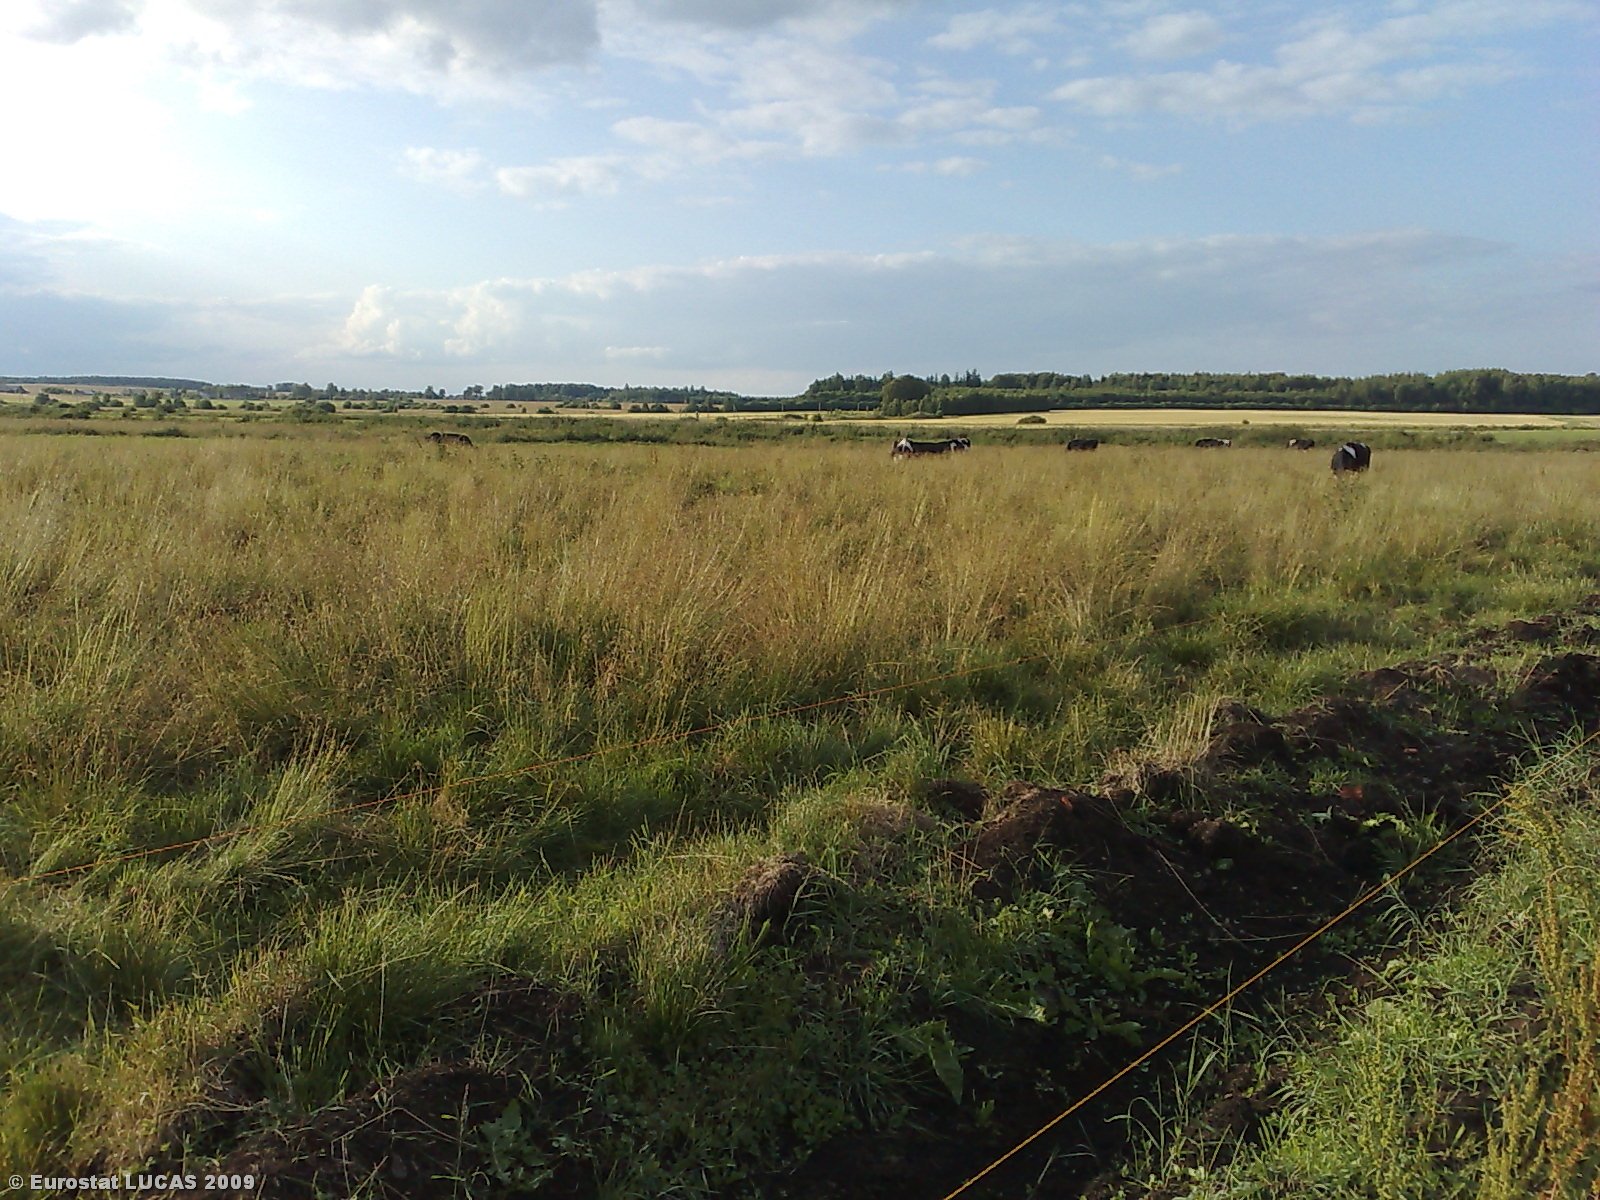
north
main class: Grassland
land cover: Grassland without tree/shrub cover
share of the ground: > 75 %
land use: Agriculture (excluding fallow land and kitchen gardens)
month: July
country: LT
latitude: 55.7767
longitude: 22.8360
